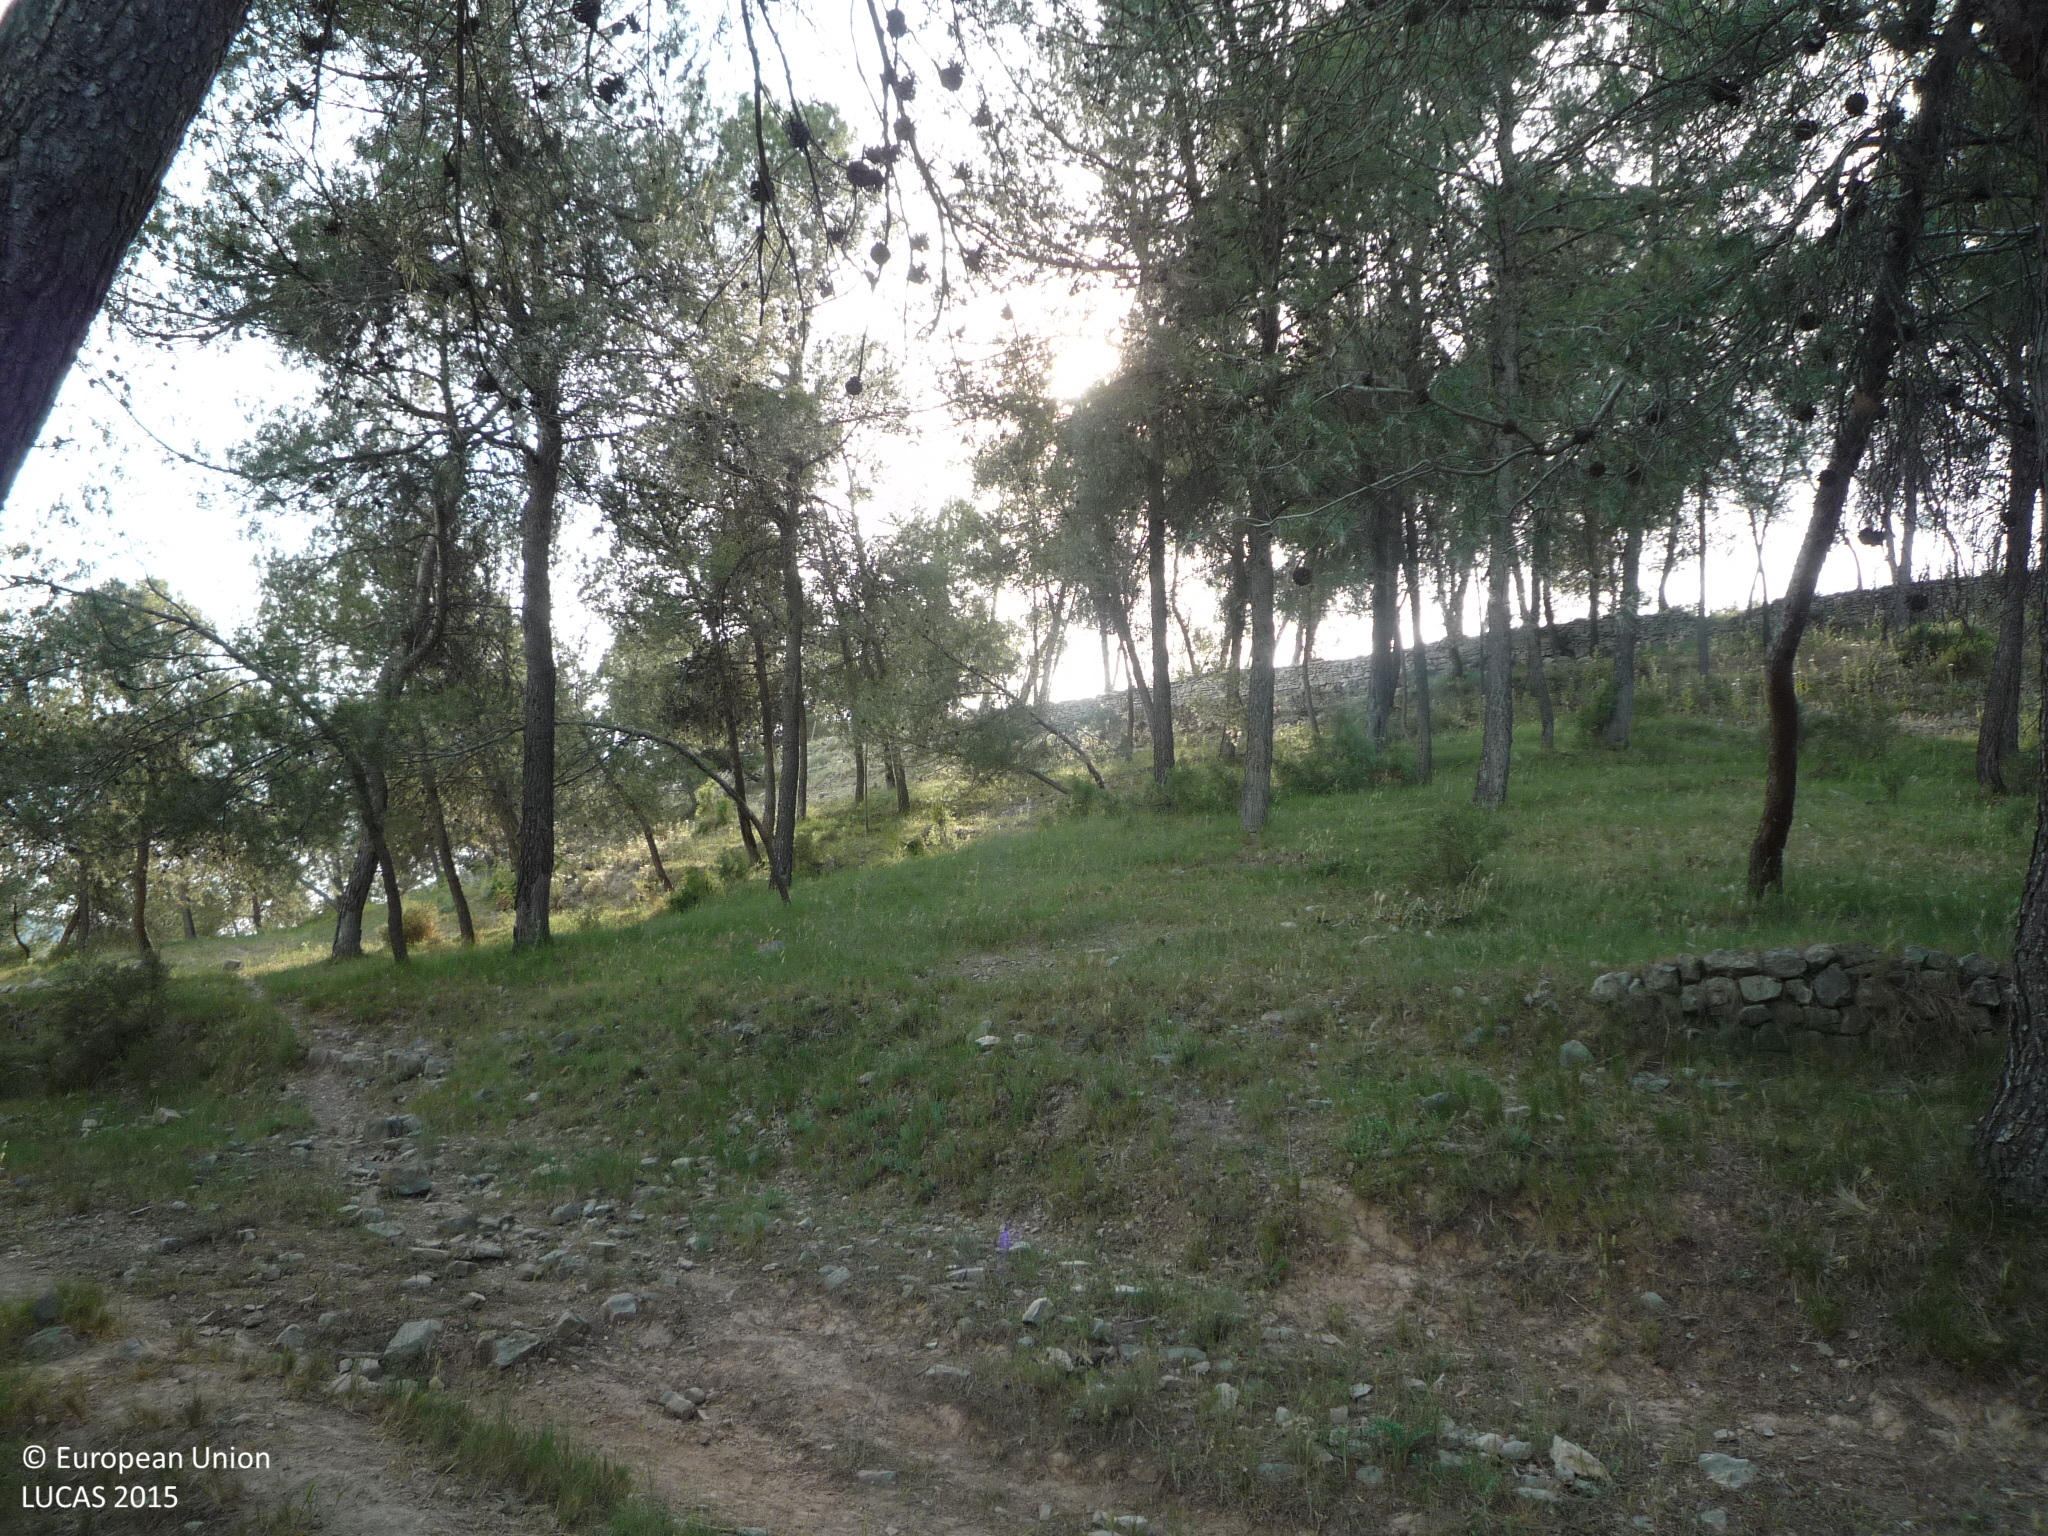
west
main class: Woodland
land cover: Pine dominated coniferous woodland
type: coniferous forest of the mediterranean region
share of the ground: > 75 %
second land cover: Grassland without tree/shrub cover
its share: 10 - 25 %
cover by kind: coniferous forest trees 75 %, herbaceous plants 25 %
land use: Forestry
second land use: Agriculture (excluding fallow land and kitchen gardens)
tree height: > 5 m
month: May
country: ES
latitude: 41.8638
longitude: 1.9793
